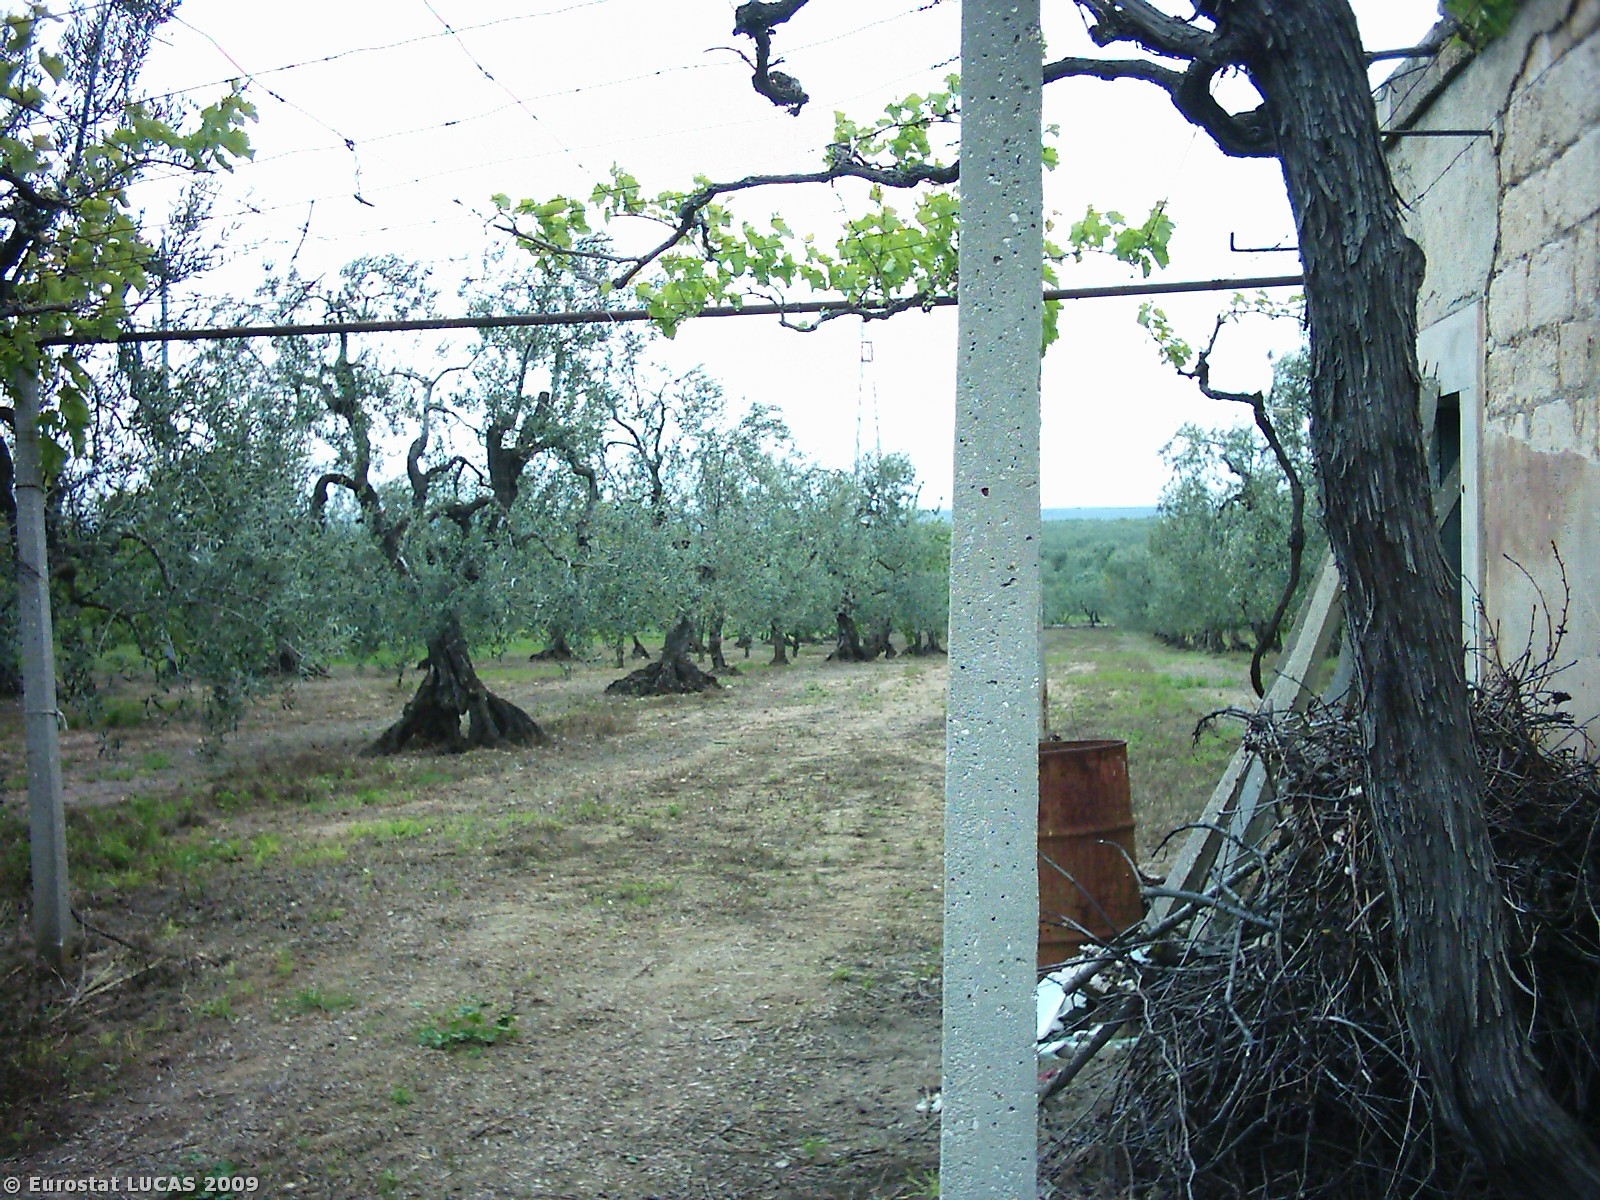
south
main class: Cropland
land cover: Olive groves
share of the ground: 10 - 25 %
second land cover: Bare land
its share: > 75 %
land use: Agriculture (excluding fallow land and kitchen gardens)
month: April
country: IT
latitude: 41.1857
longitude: 16.3581
